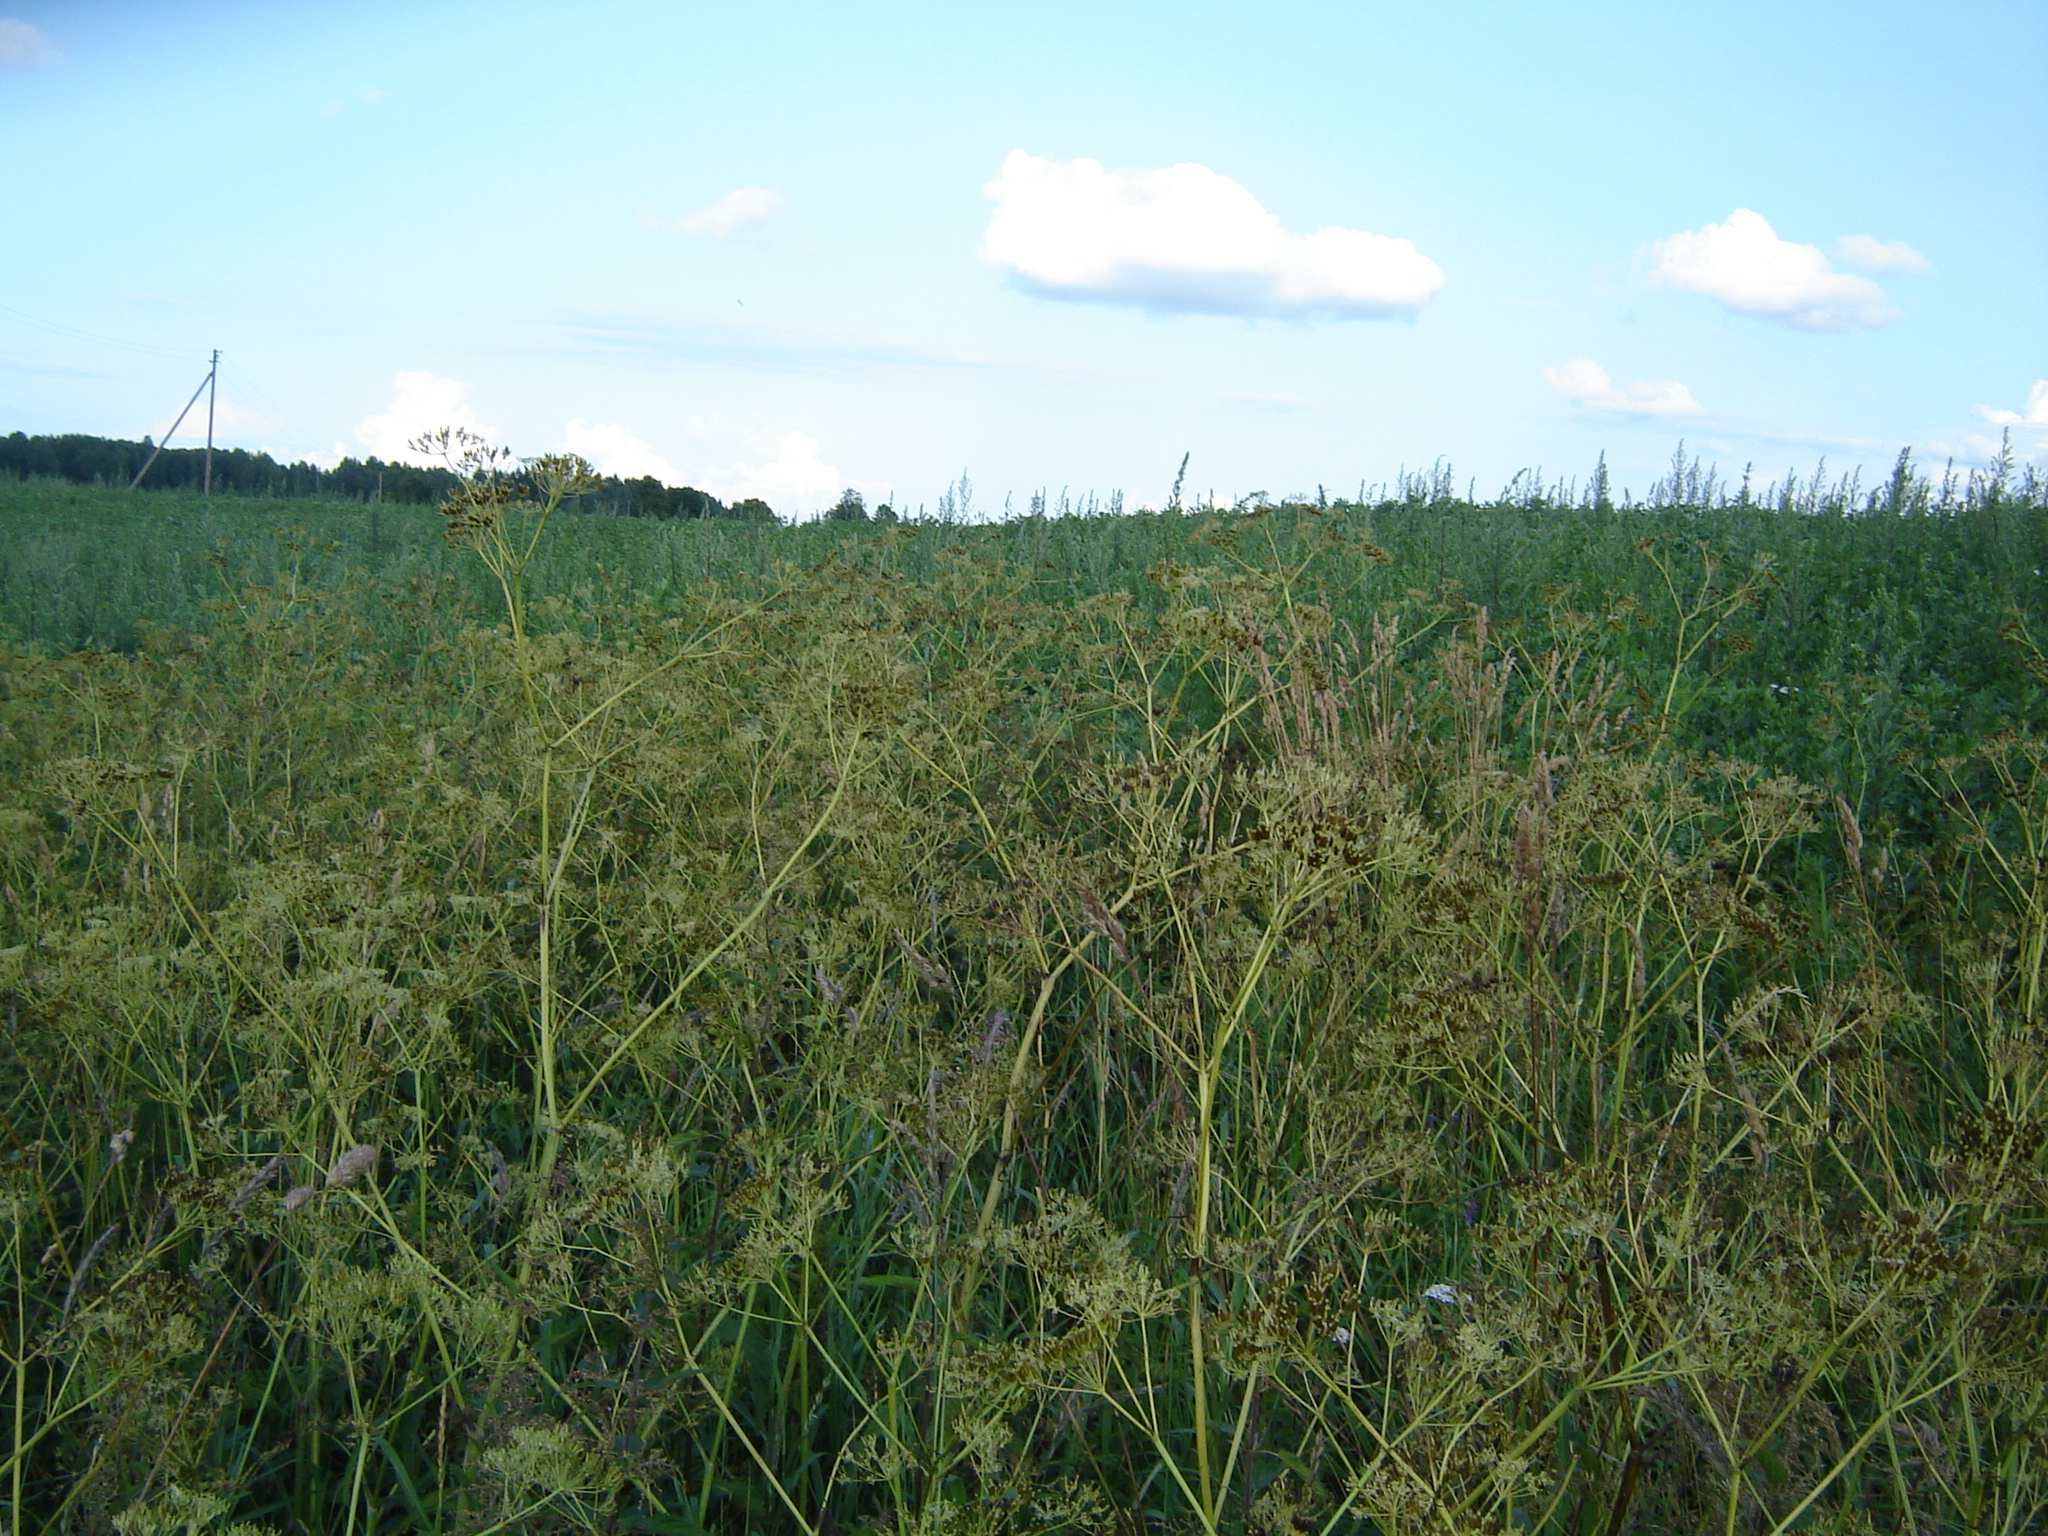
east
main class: Grassland
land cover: Spontaneously vegetated surfaces
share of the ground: > 75 %
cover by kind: herbaceous plants 100 %
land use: Fallow land
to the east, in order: Spontaneously vegetated surfaces; Dry pulses; Electric lines; Dry pulses; Barley; Abandoned hedges; Ditches and canals; Shruby margins; Barley
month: July
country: LT
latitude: 55.3649
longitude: 25.5073
